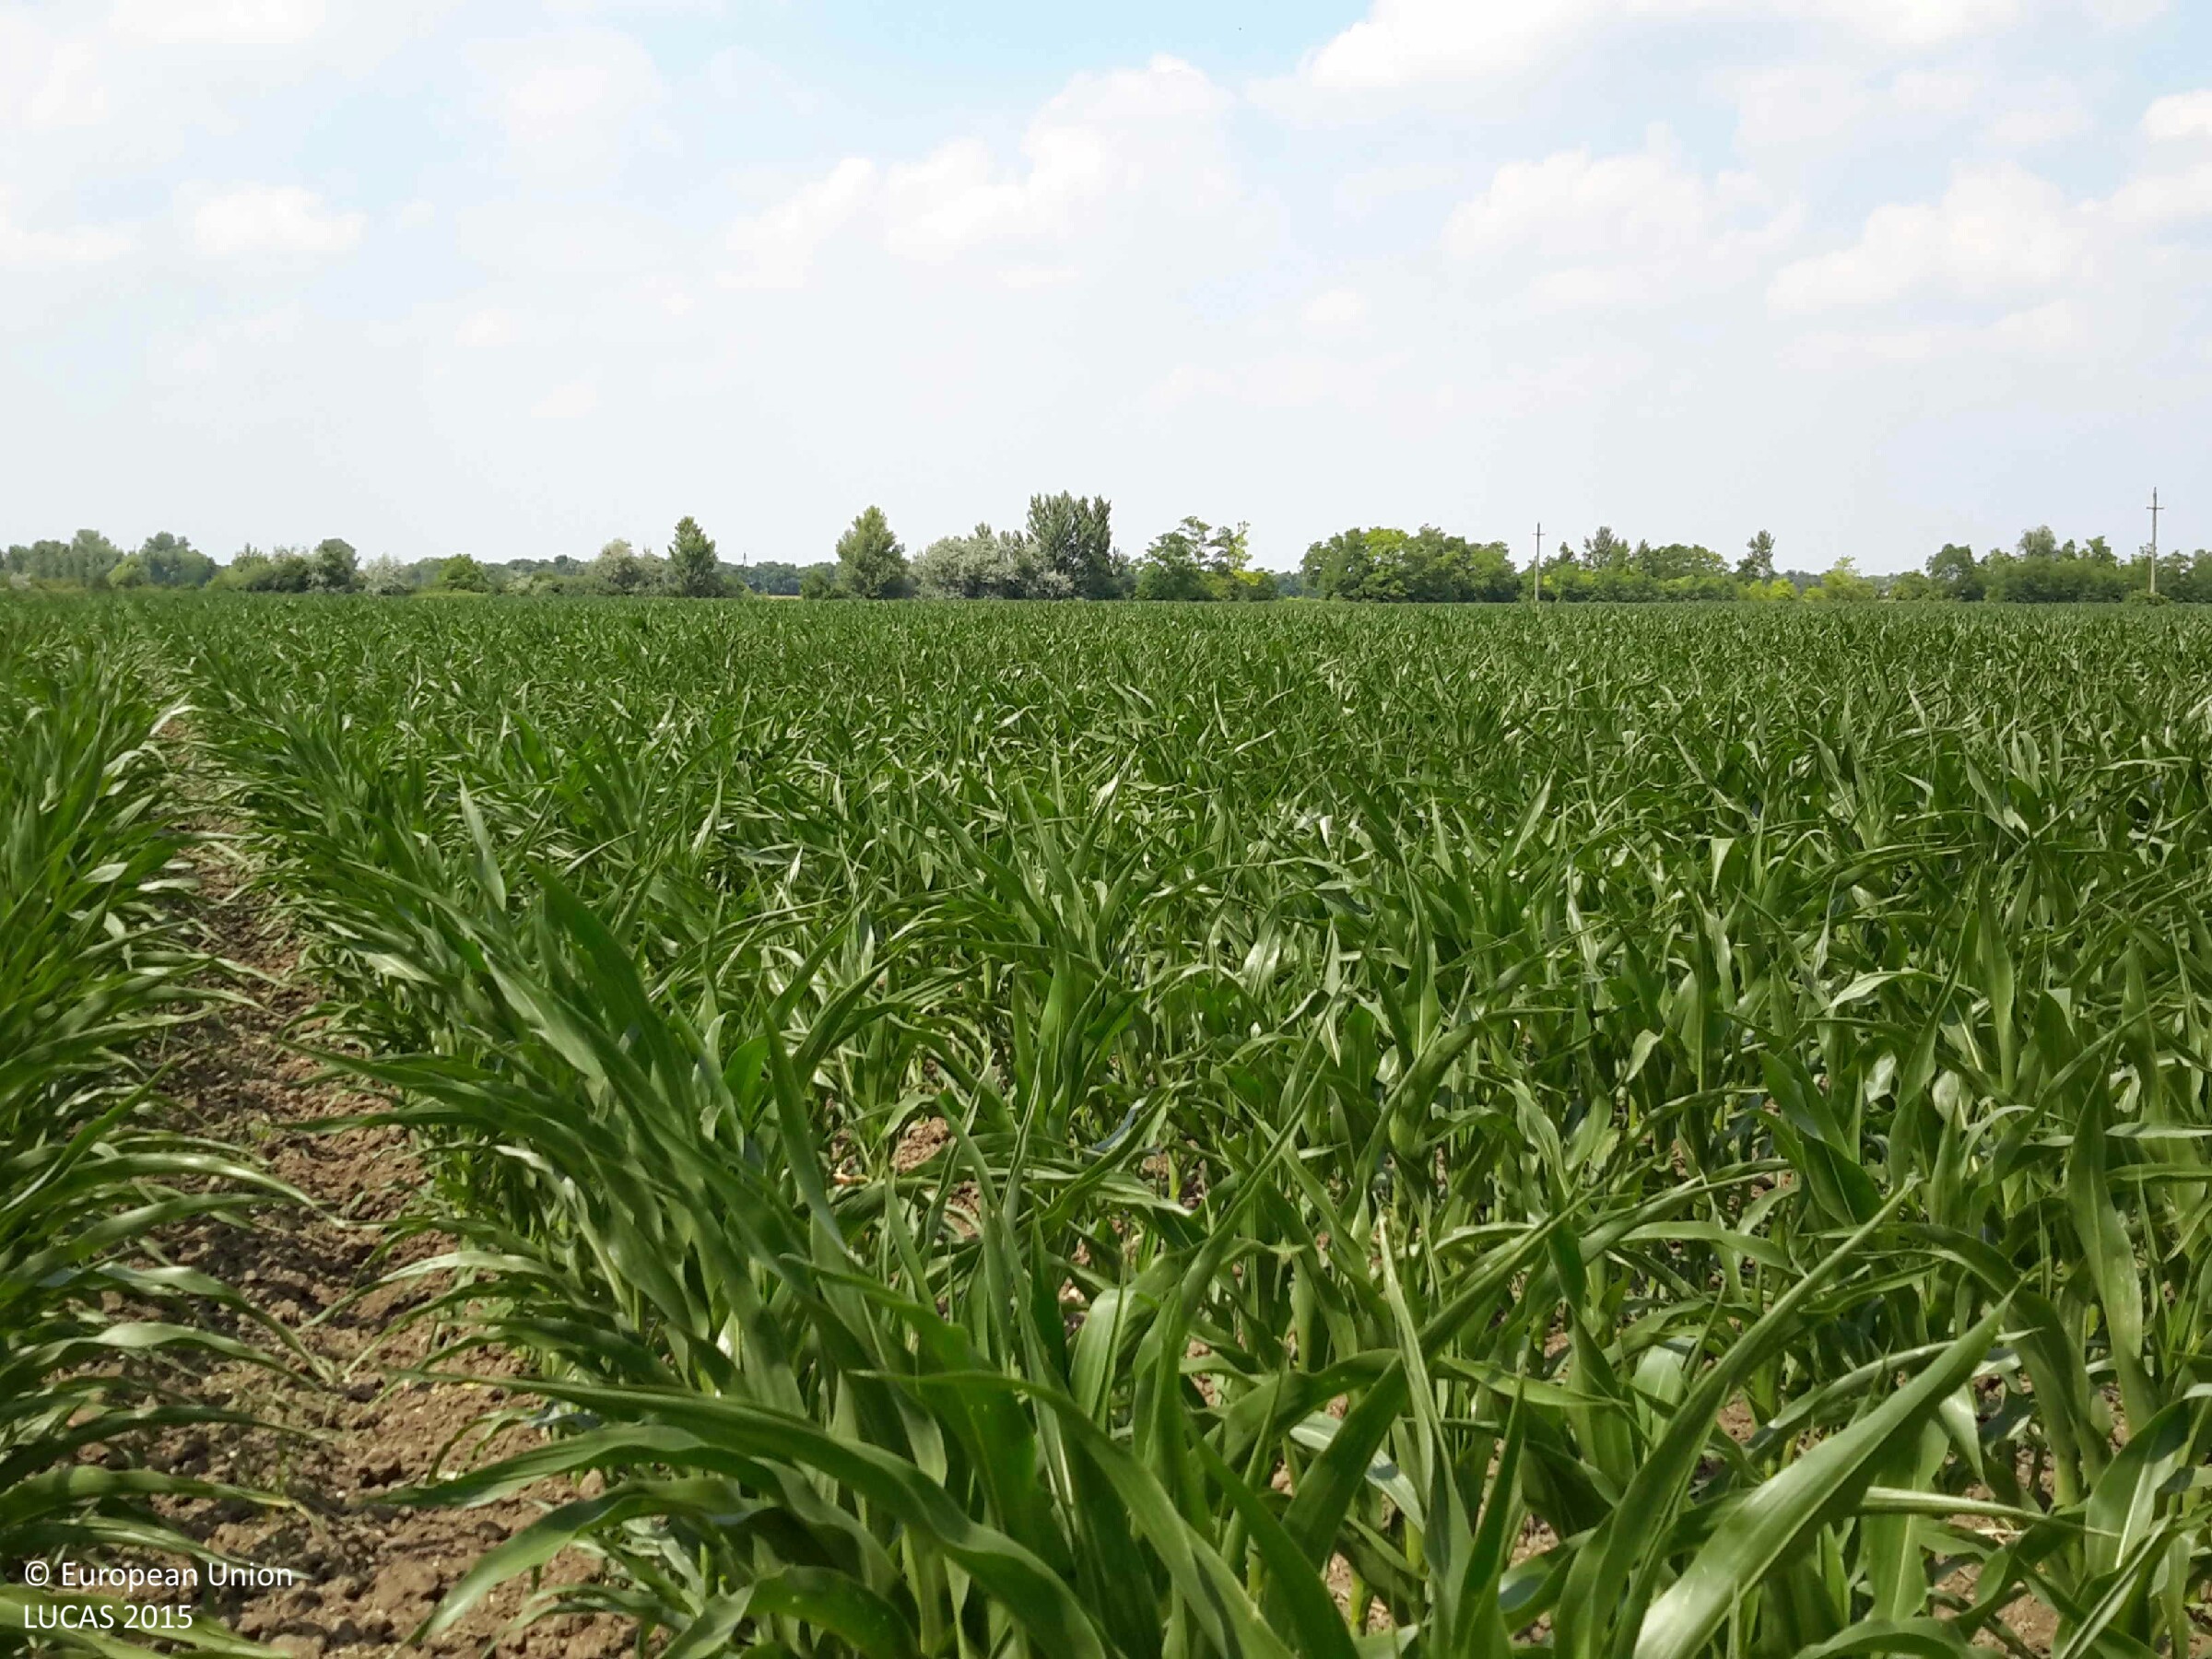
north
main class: Cropland
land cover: Maize
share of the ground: 50 - 75 %
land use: Agriculture (excluding fallow land and kitchen gardens)
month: July
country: HU
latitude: 47.3615
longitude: 17.3820
